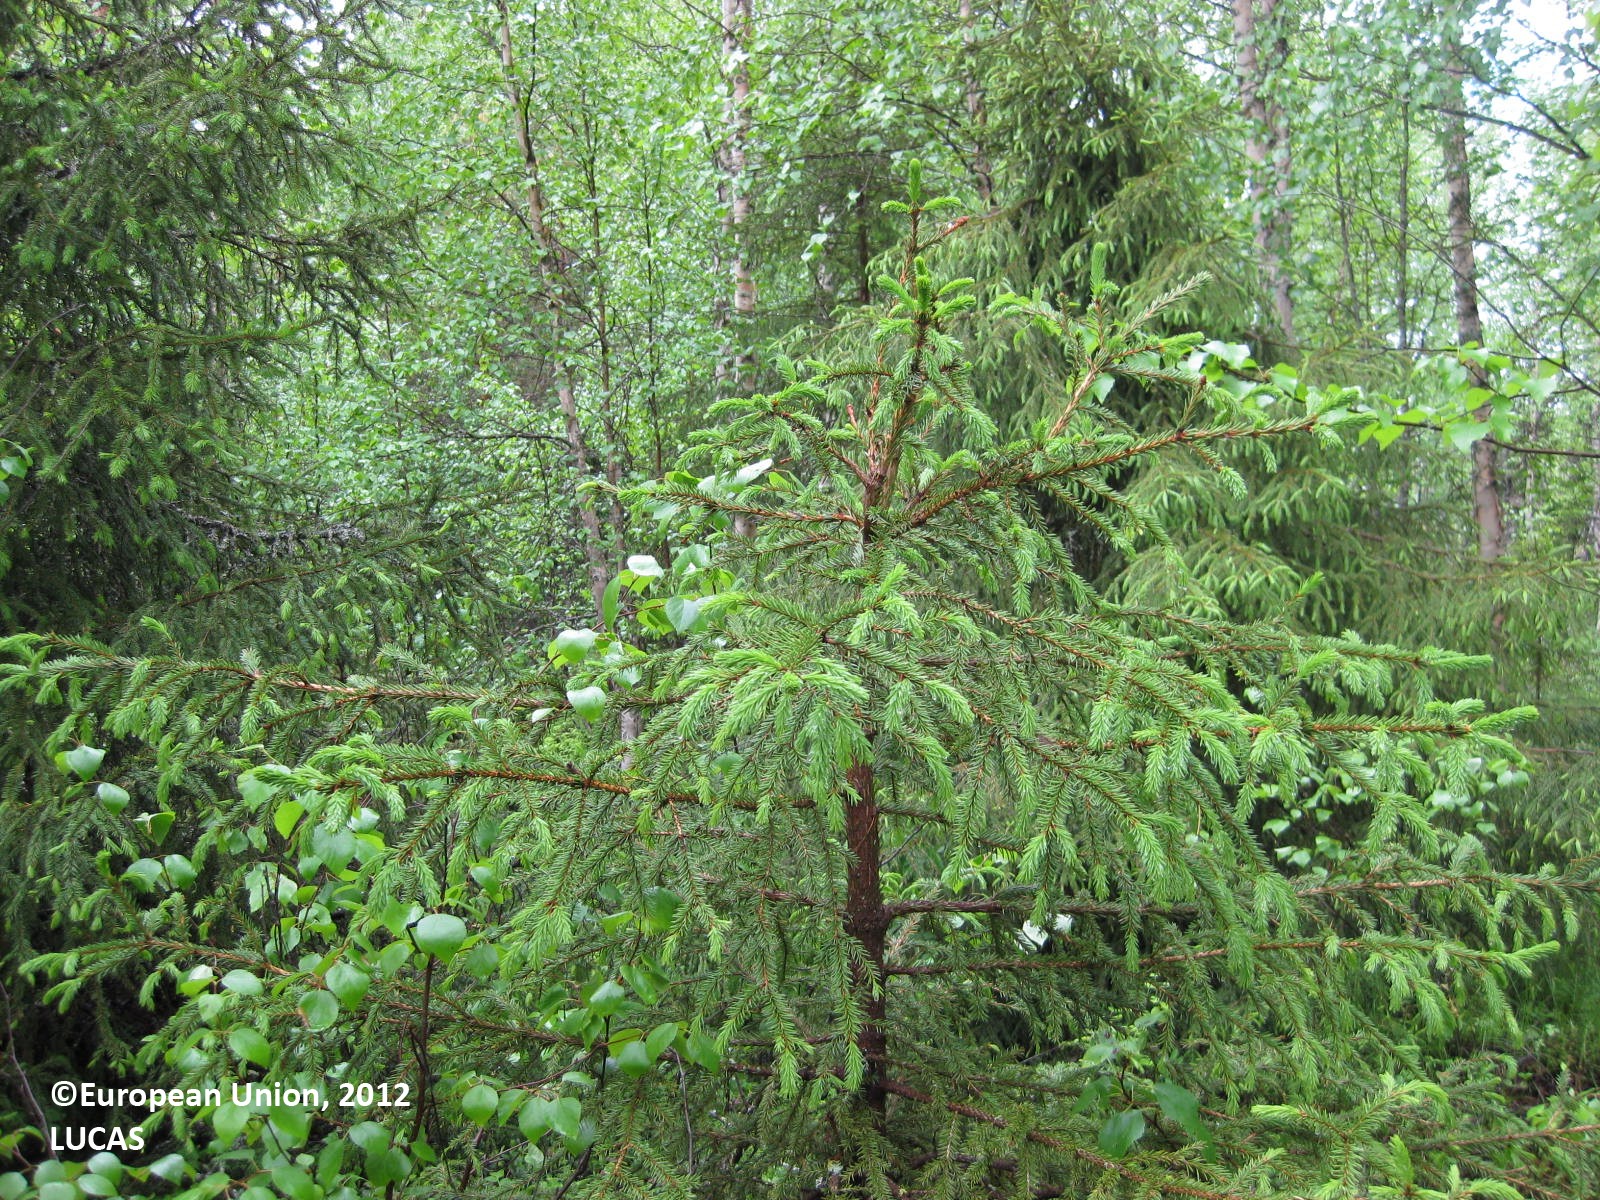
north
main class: Woodland
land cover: Other mixed woodland
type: boreal forest
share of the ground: > 75 %
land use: Forestry
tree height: > 5 m
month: June
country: FI
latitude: 65.0837
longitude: 29.0129
